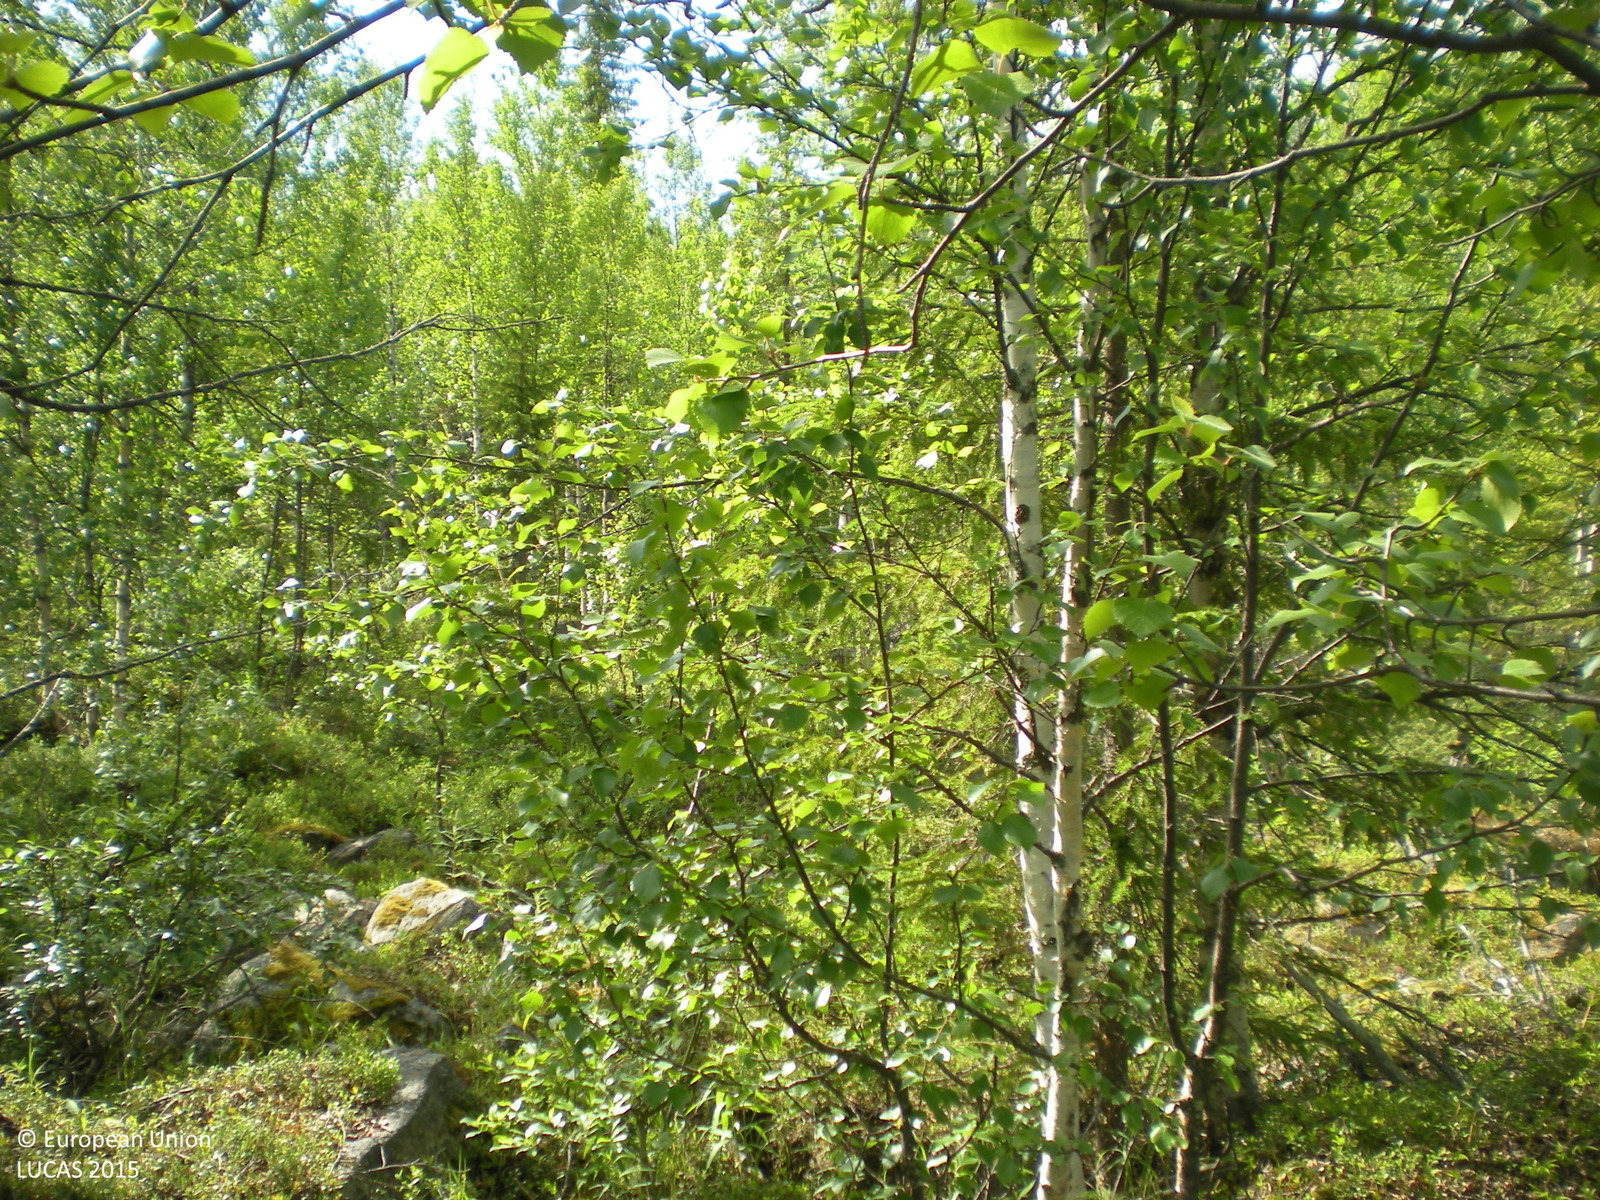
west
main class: Woodland
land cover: Spruce dominated mixed woodland
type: boreal forest
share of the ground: 50 - 75 %
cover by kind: broadleaved forest trees 50 %, coniferous forest trees 20 %, consolidated bare surface 15 %, herbaceous plants 10 %, shrubs 5 %
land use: Forestry
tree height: < 5 m
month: July
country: SE
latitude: 65.5720
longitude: 16.9164
